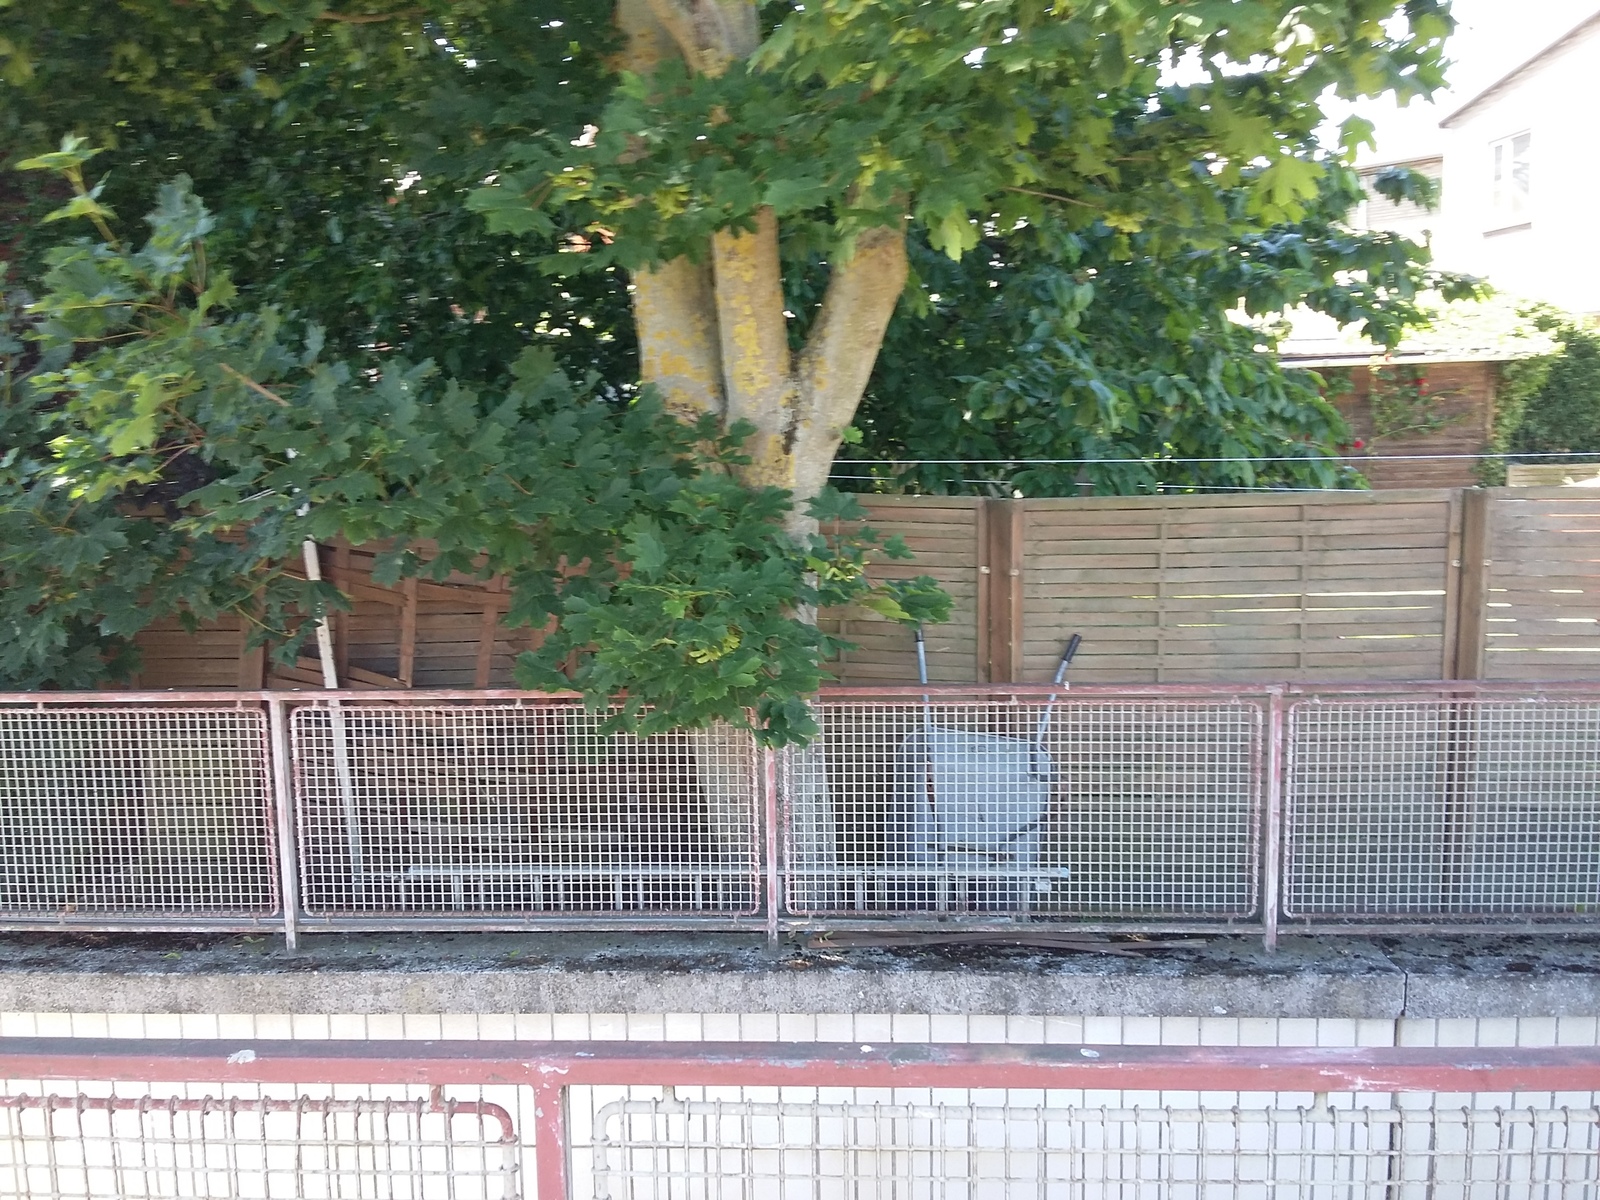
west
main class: Woodland
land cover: Broadleaved woodland
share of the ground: > 75 %
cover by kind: broadleaved forest trees 80 %, herbaceous plants 20 %
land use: Residential
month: June
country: DK
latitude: 54.8974
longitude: 11.8855
